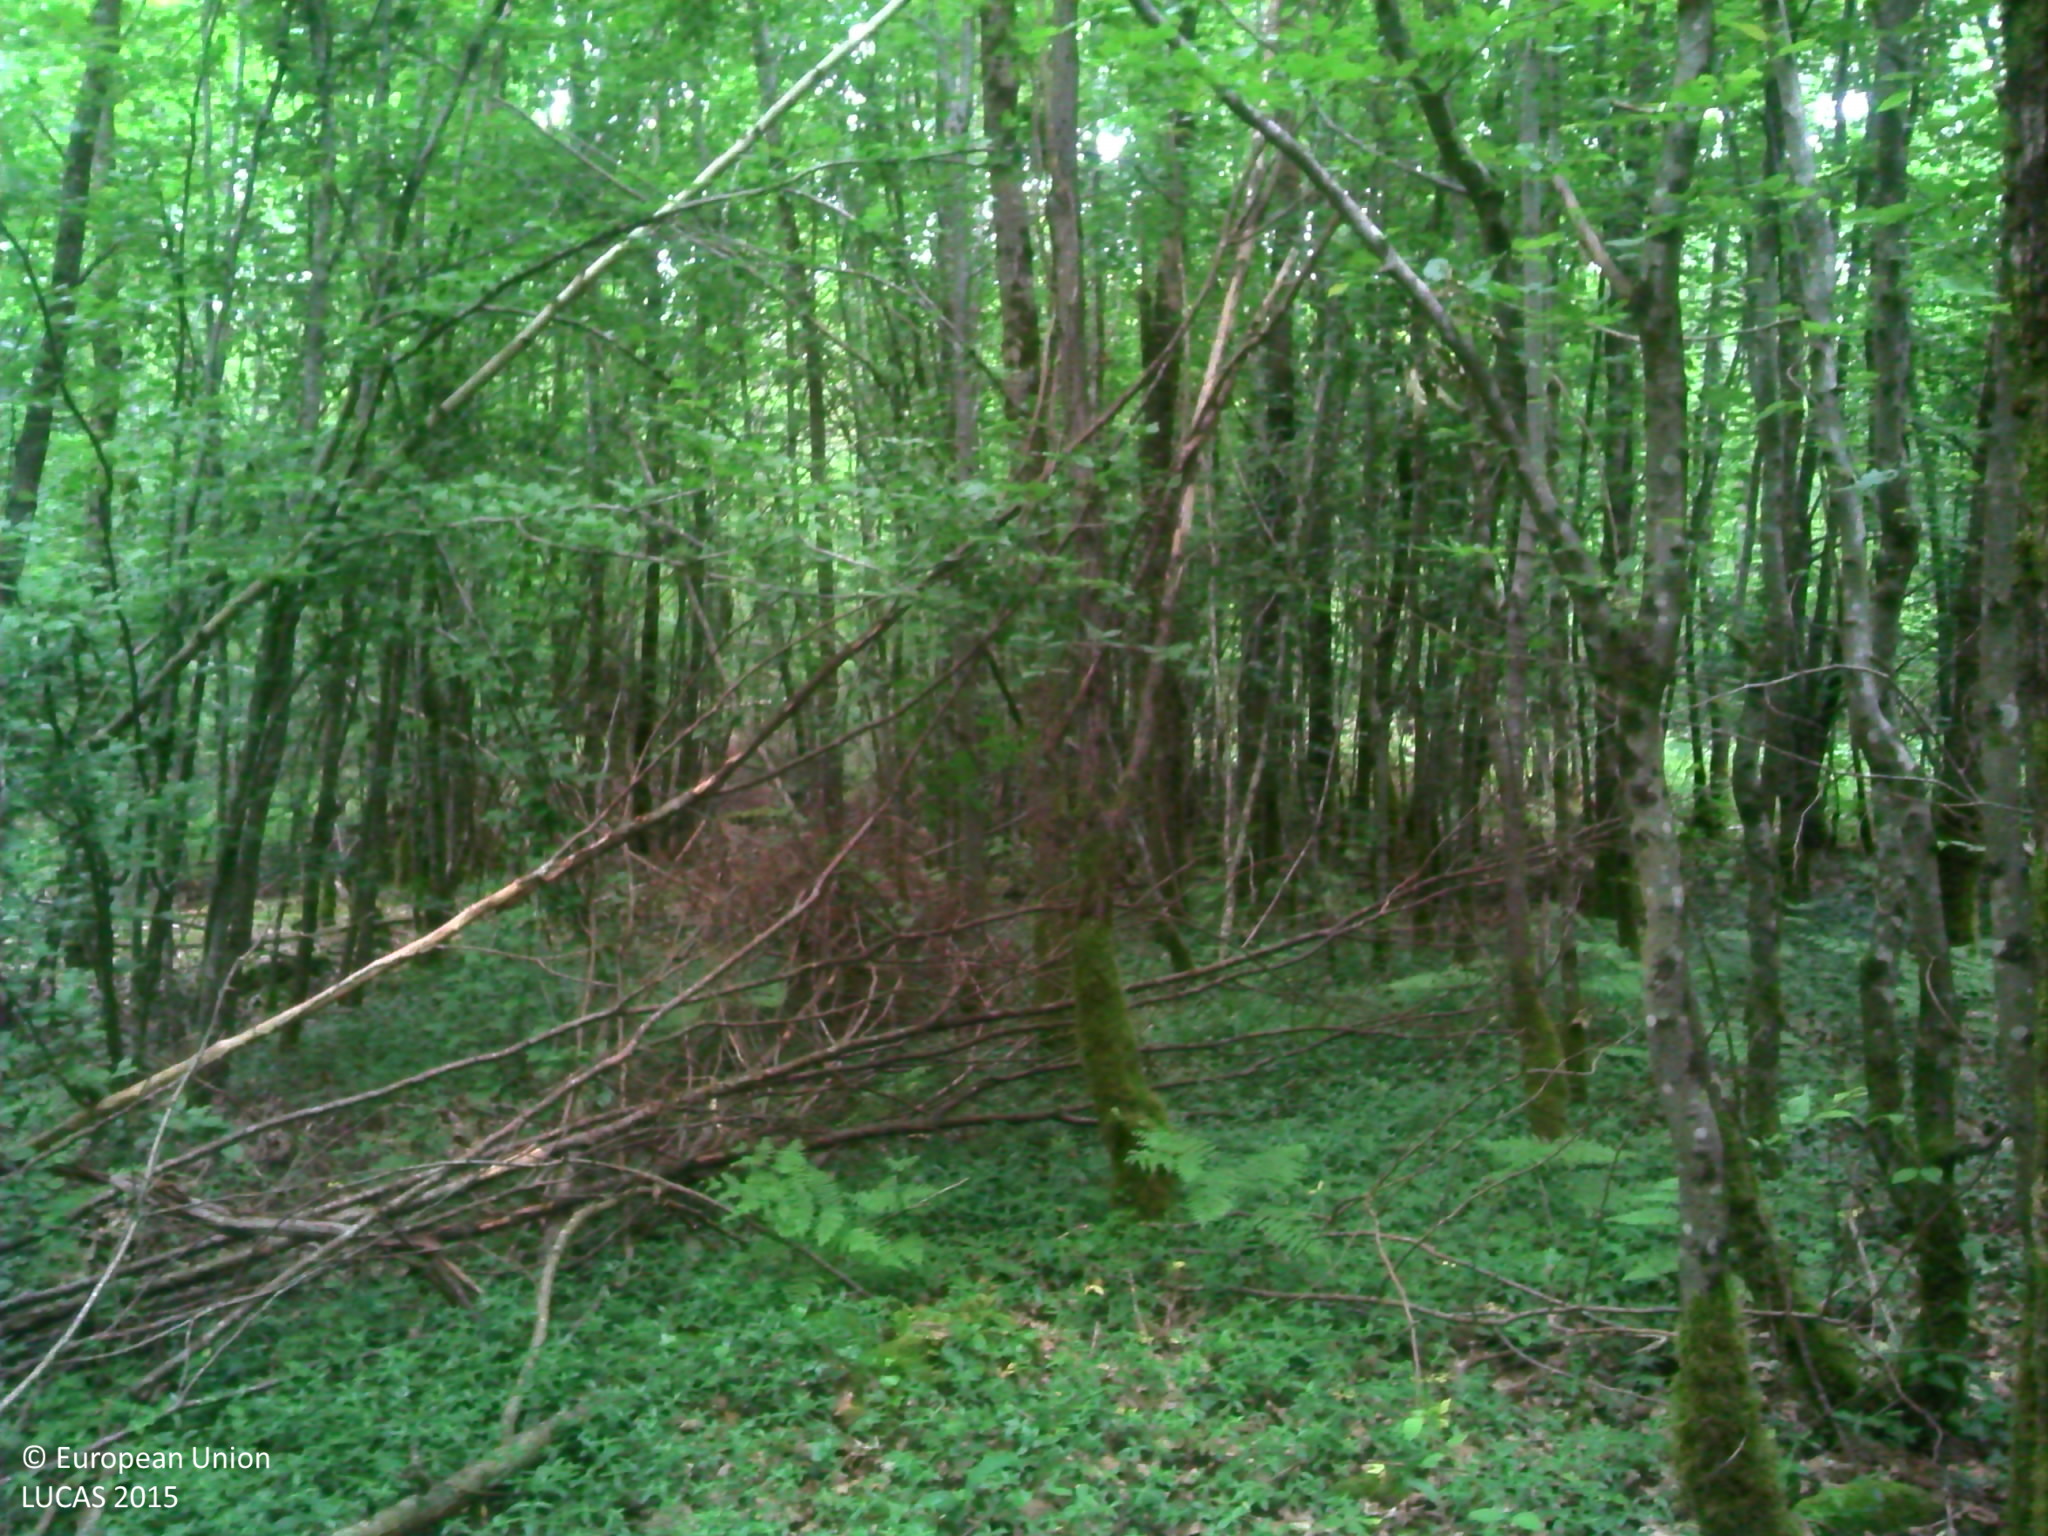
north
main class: Woodland
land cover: Broadleaved woodland
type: mesophytic deciduous forest
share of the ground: > 75 %
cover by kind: broadleaved forest trees 90 %, herbaceous plants 10 %
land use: Forestry
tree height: > 5 m
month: June
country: FR
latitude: 48.5379
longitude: 4.8921
